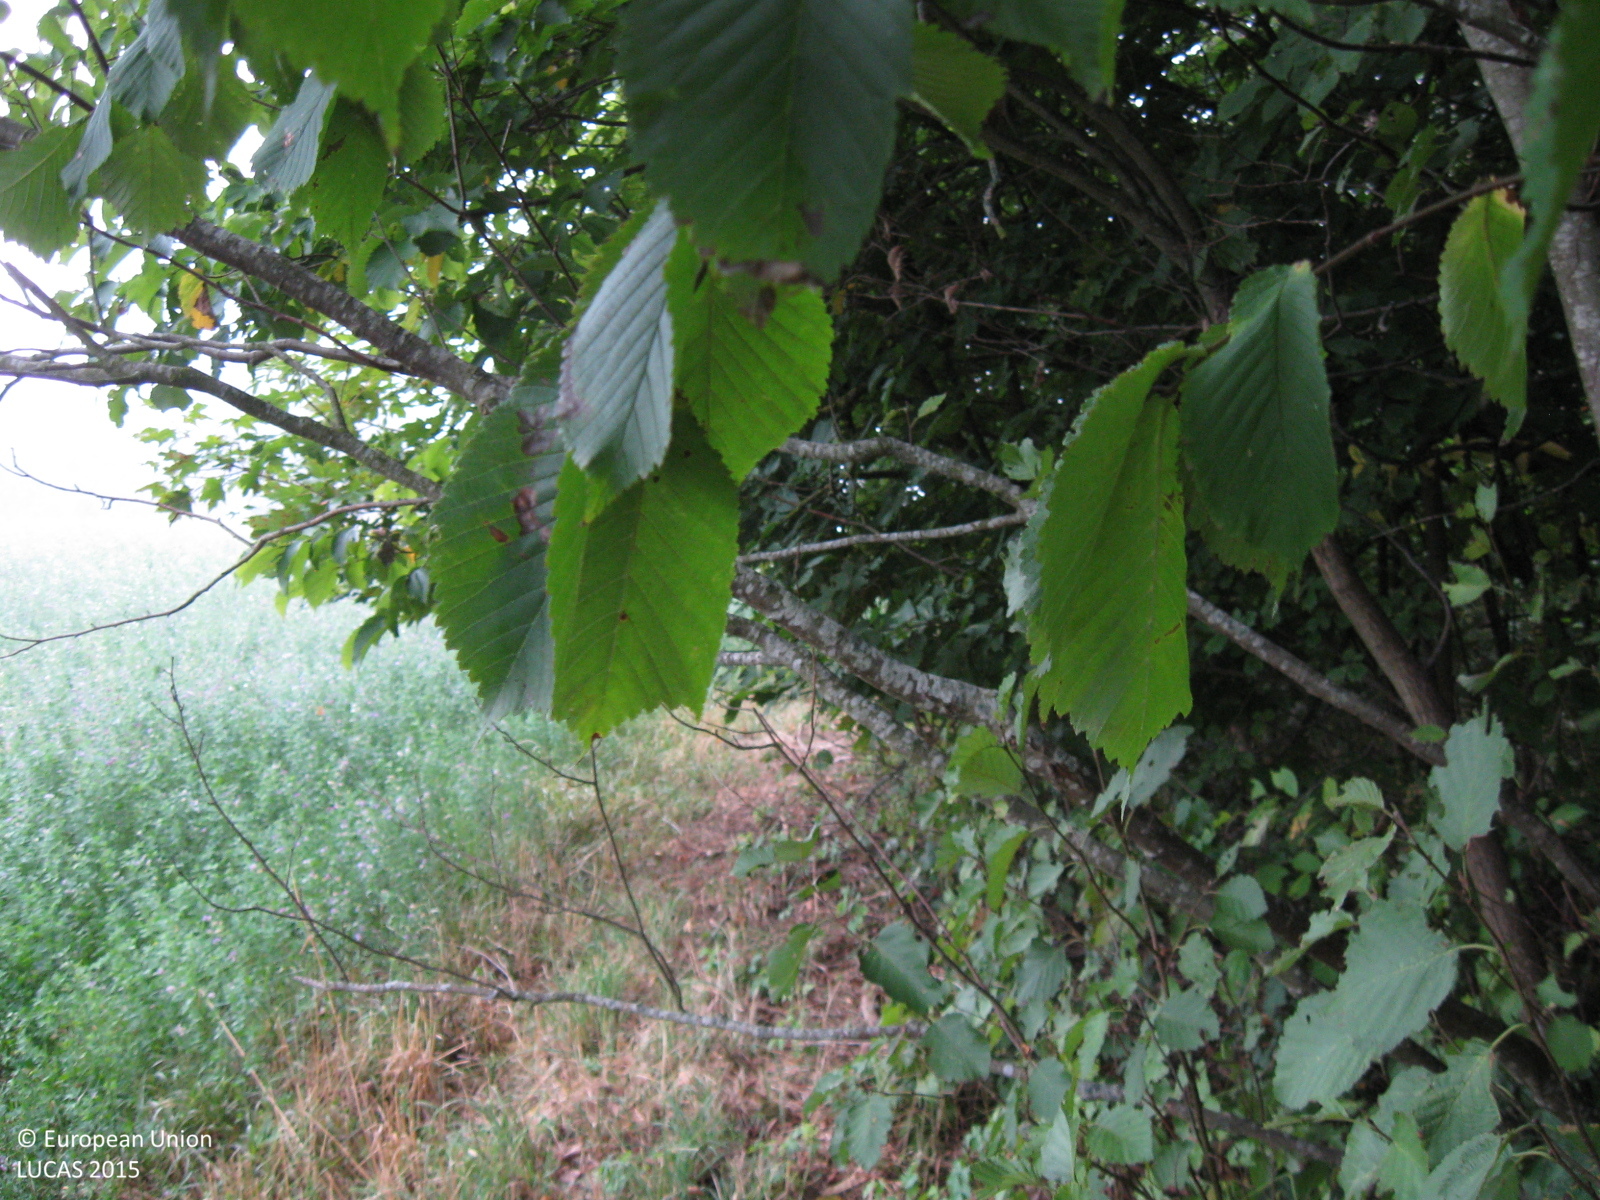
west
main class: Woodland
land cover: Broadleaved woodland
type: non-riverine alder, birch or aspen forest
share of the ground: > 75 %
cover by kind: broadleaved forest trees 95 %, herbaceous plants 5 %
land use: Forestry
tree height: > 5 m
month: September
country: LT
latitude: 55.0935
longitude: 23.0940
